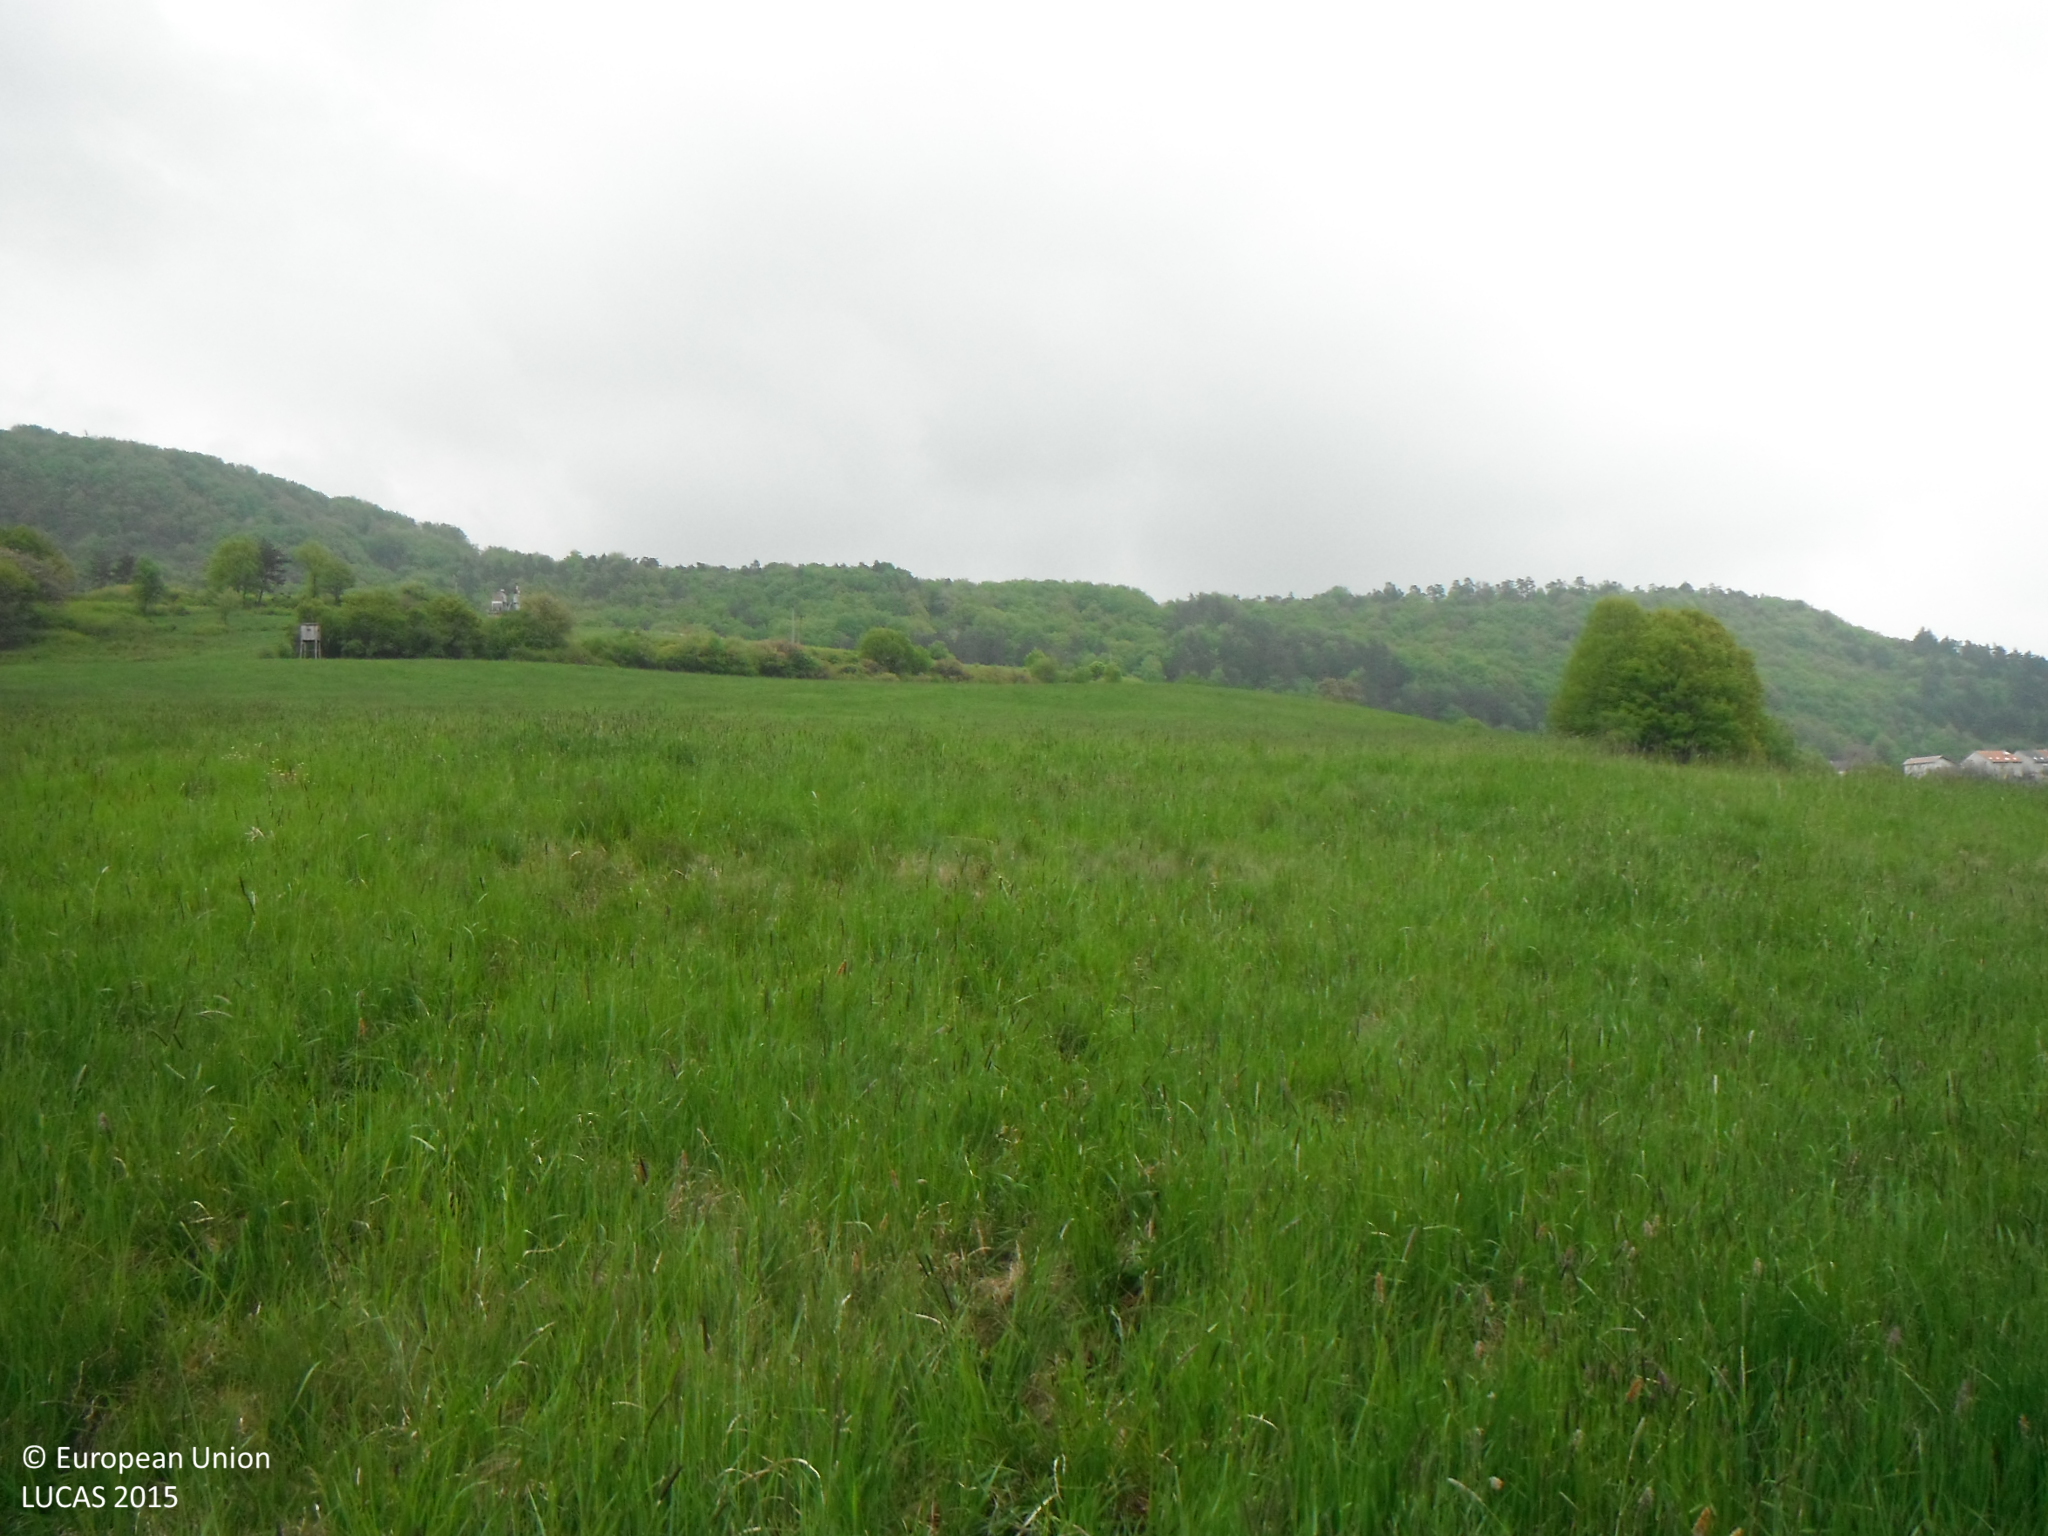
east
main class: Grassland
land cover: Grassland without tree/shrub cover
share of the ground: > 75 %
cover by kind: herbaceous plants 100 %
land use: Agriculture (excluding fallow land and kitchen gardens)
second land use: Other primary production
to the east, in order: Grassland without tree/shrub cover; Shrubland without tree cover; Grassland without tree/shrub cover
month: May
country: SK
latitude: 48.6005
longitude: 18.9569
